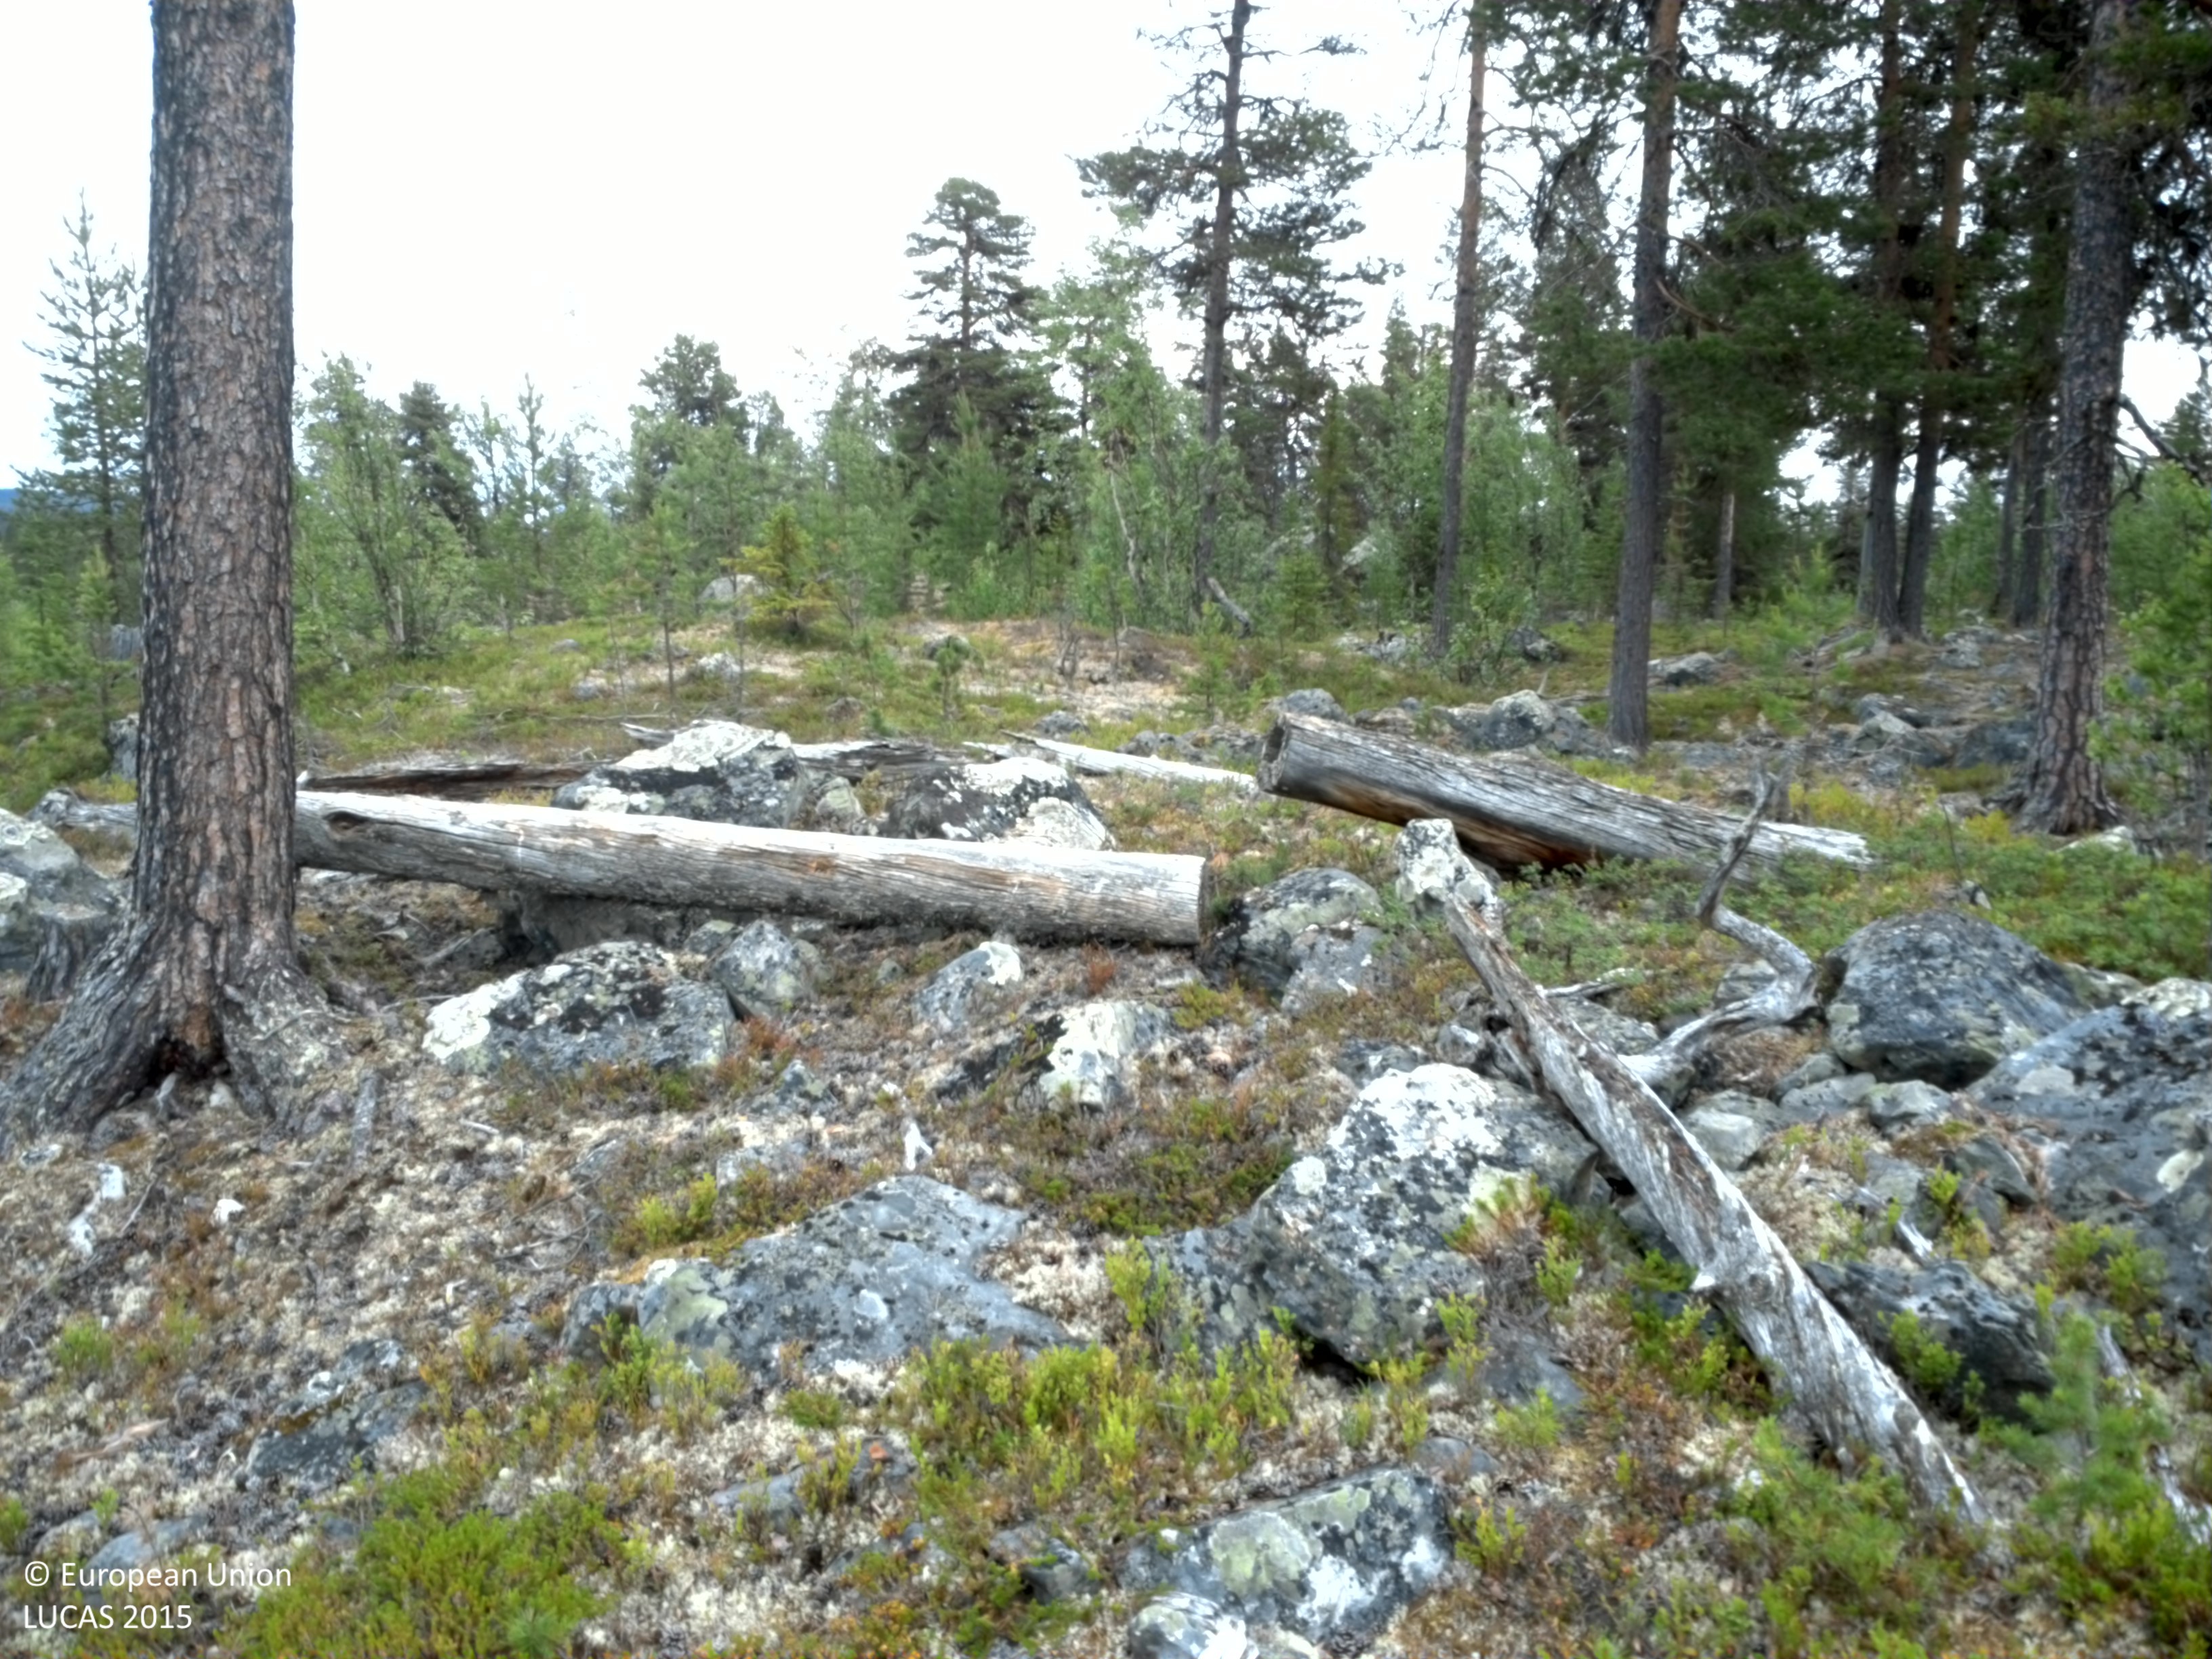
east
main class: Woodland
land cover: Pine dominated mixed woodland
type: exotic forest
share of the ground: 10 - 25 %
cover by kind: shrubs 35 %, lichens and mosses 30 %, consolidated bare surface 15 %, coniferous forest trees 10 %, broadleaved forest trees 10 %
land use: Forestry
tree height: < 5 m
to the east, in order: Pine dominated mixed woodland; Shrubland with sparse tree cover; Pine dominated mixed woodland
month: August
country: SE
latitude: 65.0566
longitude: 16.1918
